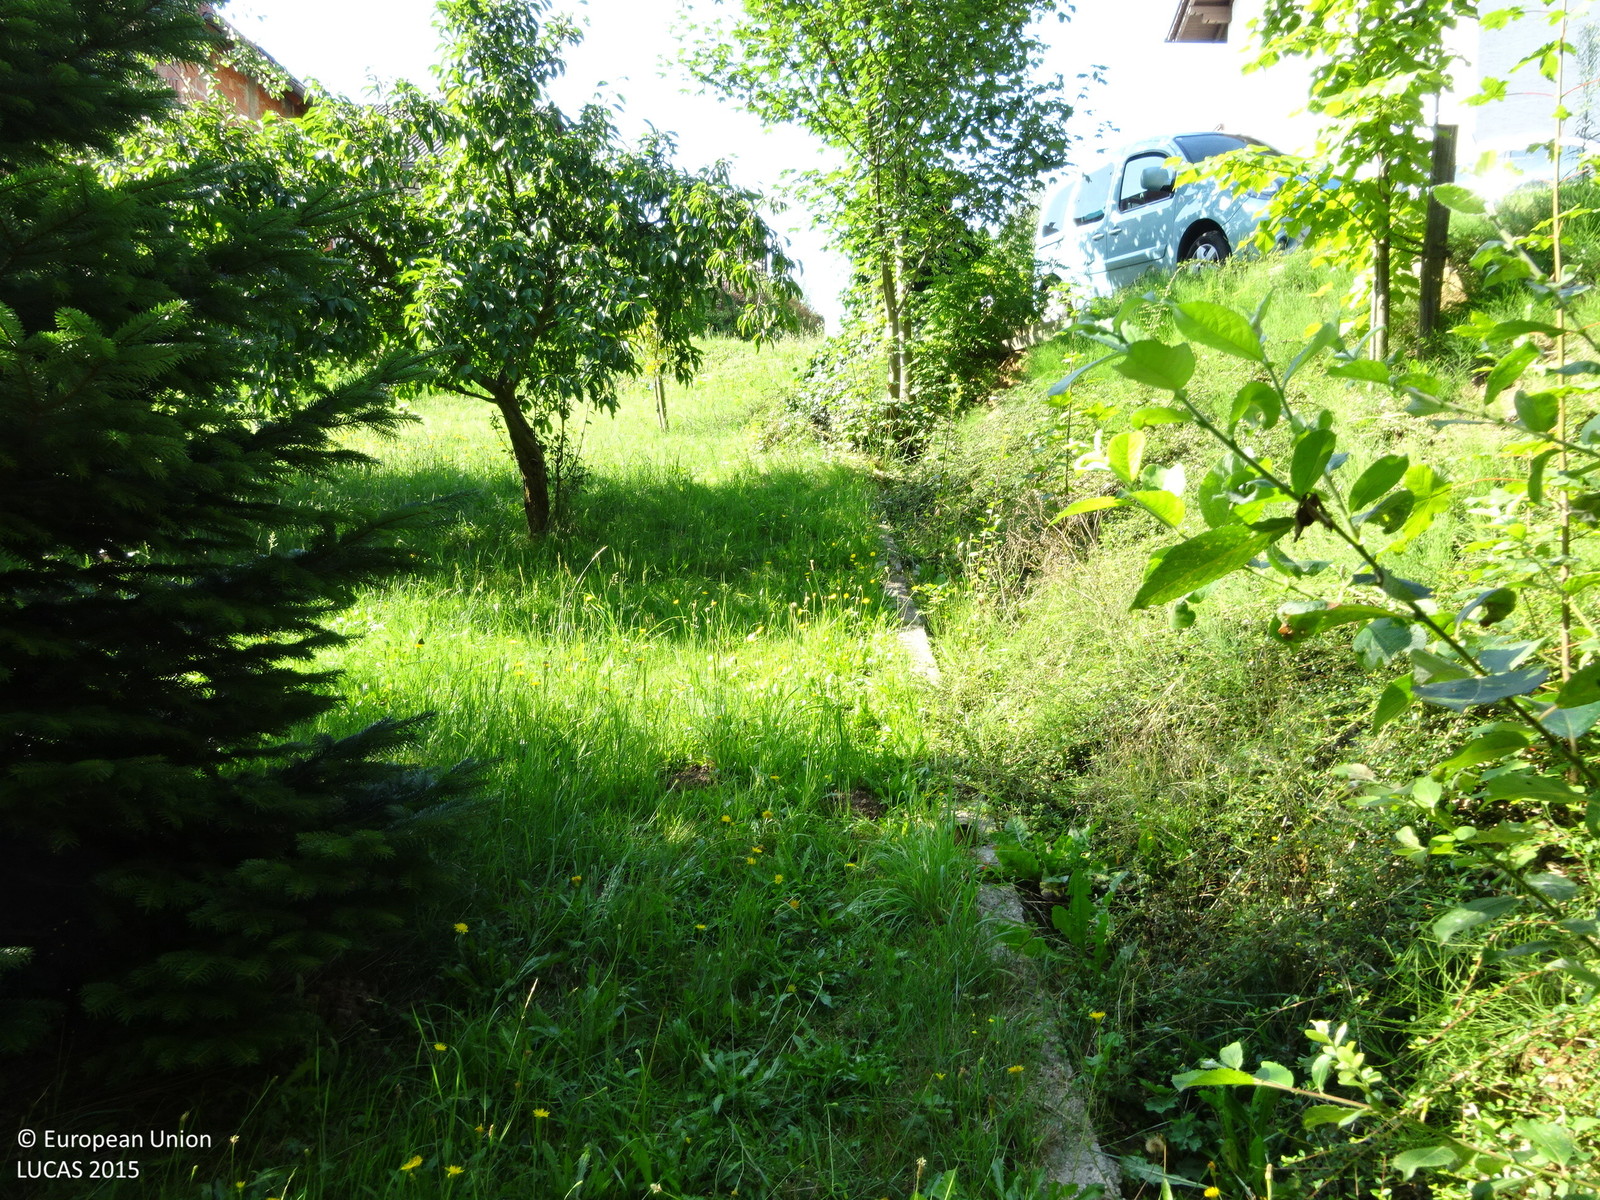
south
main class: Woodland
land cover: Broadleaved woodland
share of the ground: 25 - 50 %
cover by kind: herbaceous plants 55 %, broadleaved forest trees 25 %, unconsolidated bare surface 20 %
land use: Residential
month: August
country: AT
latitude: 47.3937
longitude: 15.9770
